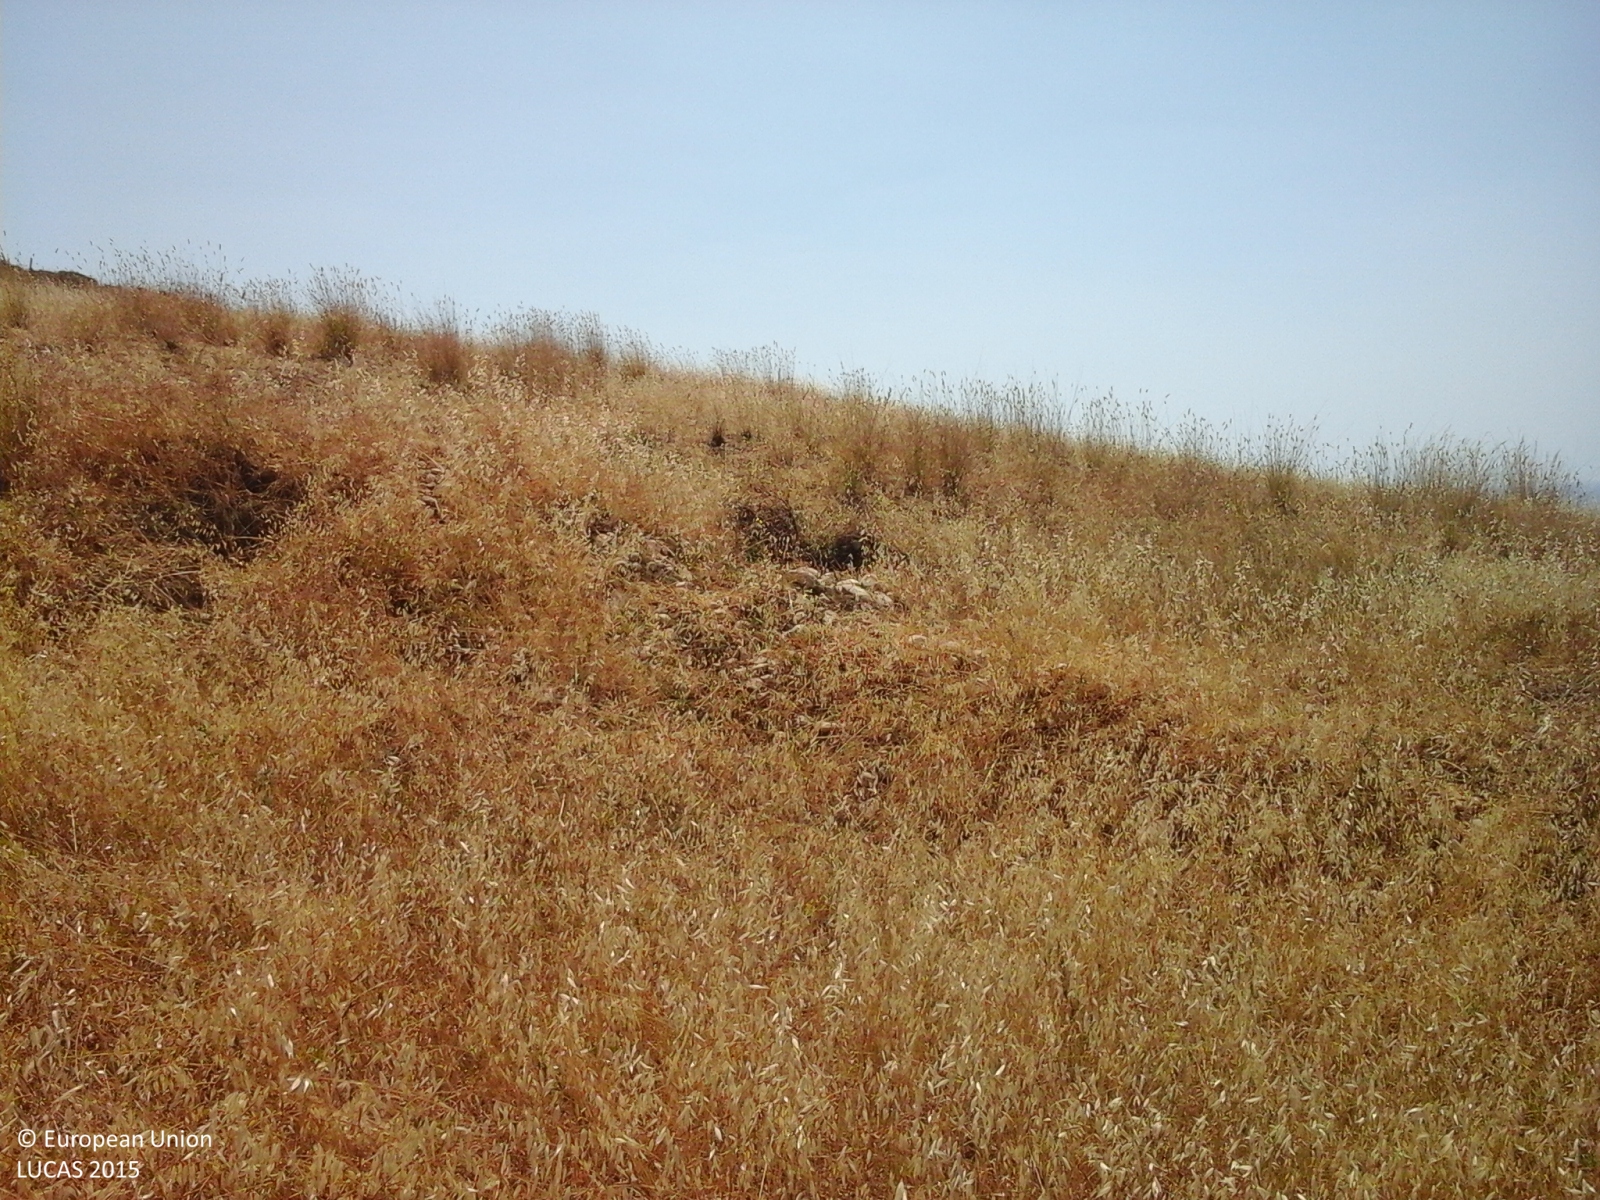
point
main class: Grassland
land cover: Spontaneously vegetated surfaces
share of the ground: > 75 %
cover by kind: herbaceous plants 100 %
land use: Fallow land
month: July
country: IT
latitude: 37.4750
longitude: 13.2205
